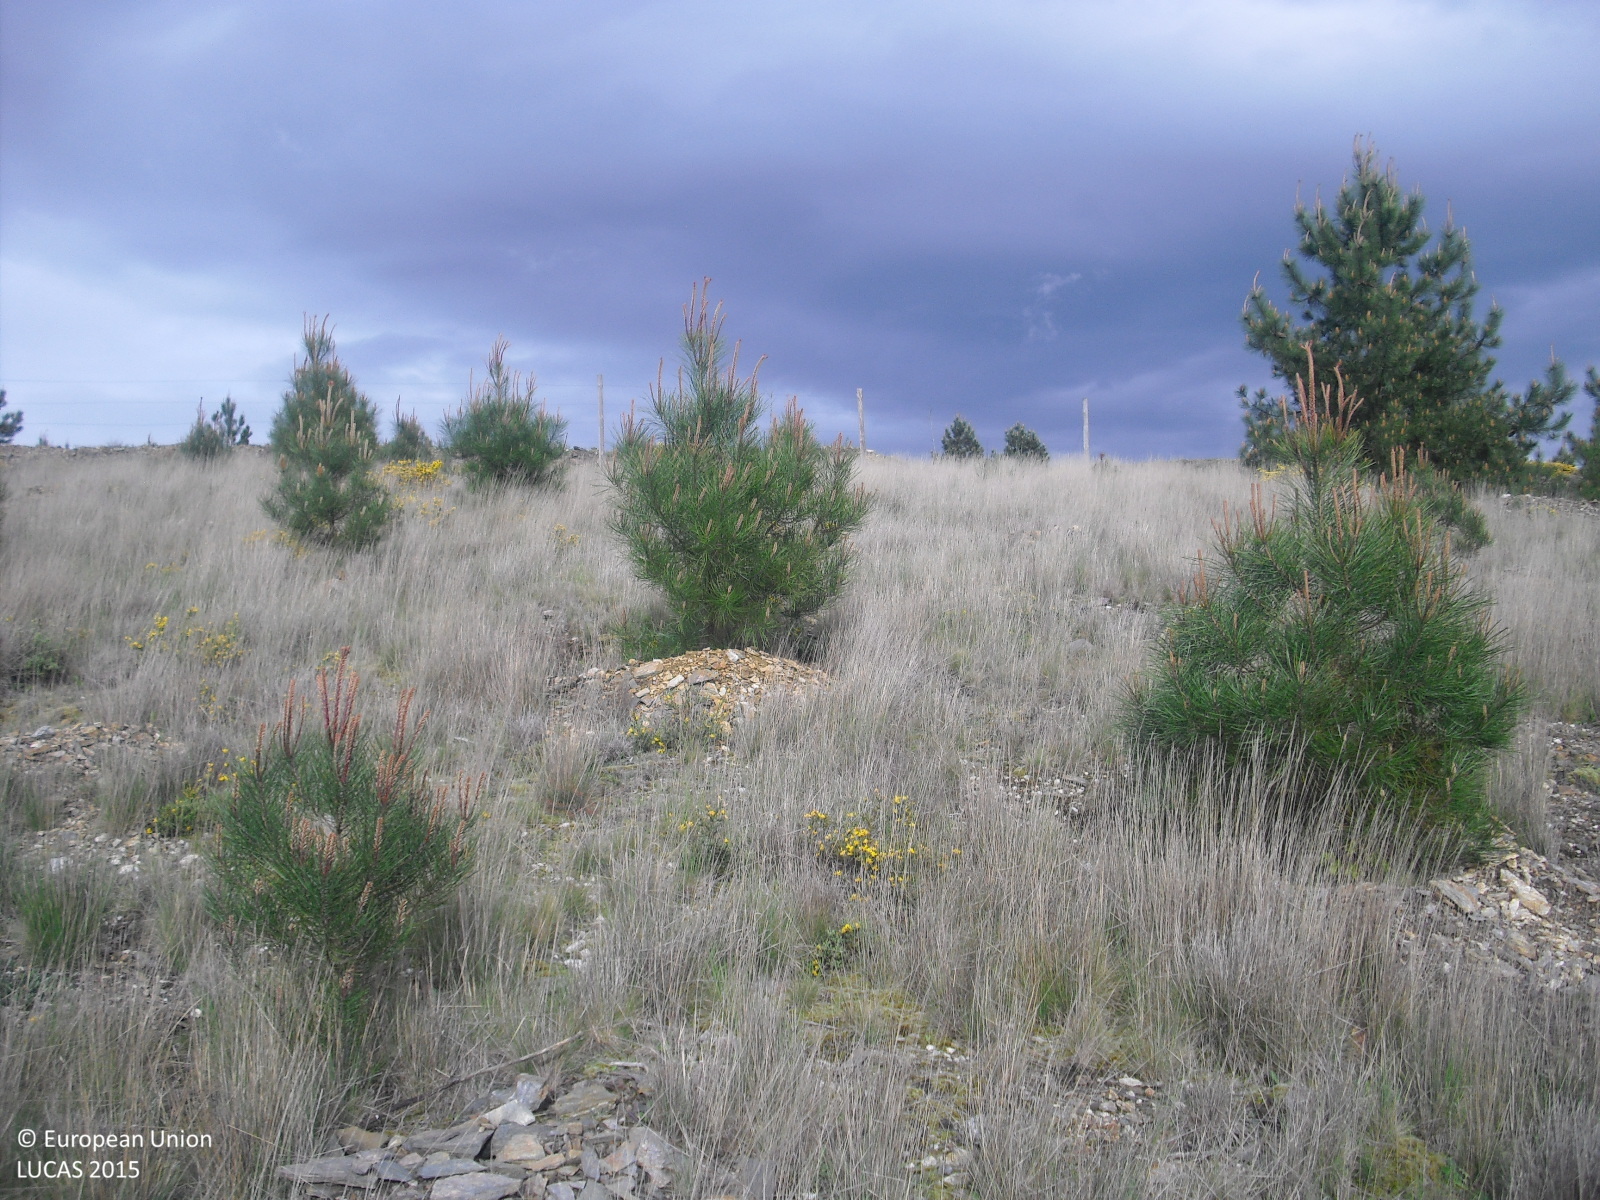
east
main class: Woodland
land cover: Pine dominated coniferous woodland
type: exotic forest
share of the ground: 10 - 25 %
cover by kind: shrubs 30 %, herbaceous plants 30 %, unconsolidated bare surface 30 %, coniferous forest trees 10 %
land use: Forestry
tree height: < 5 m
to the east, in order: Pine dominated coniferous woodland; Fences; Spontaneously vegetated surfaces; Other bare soil; Single bushes/trees; Shruby margins; Pine dominated coniferous woodland; Tracks; Pine dominated coniferous woodland
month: April
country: ES
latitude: 41.9958
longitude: -7.5314
